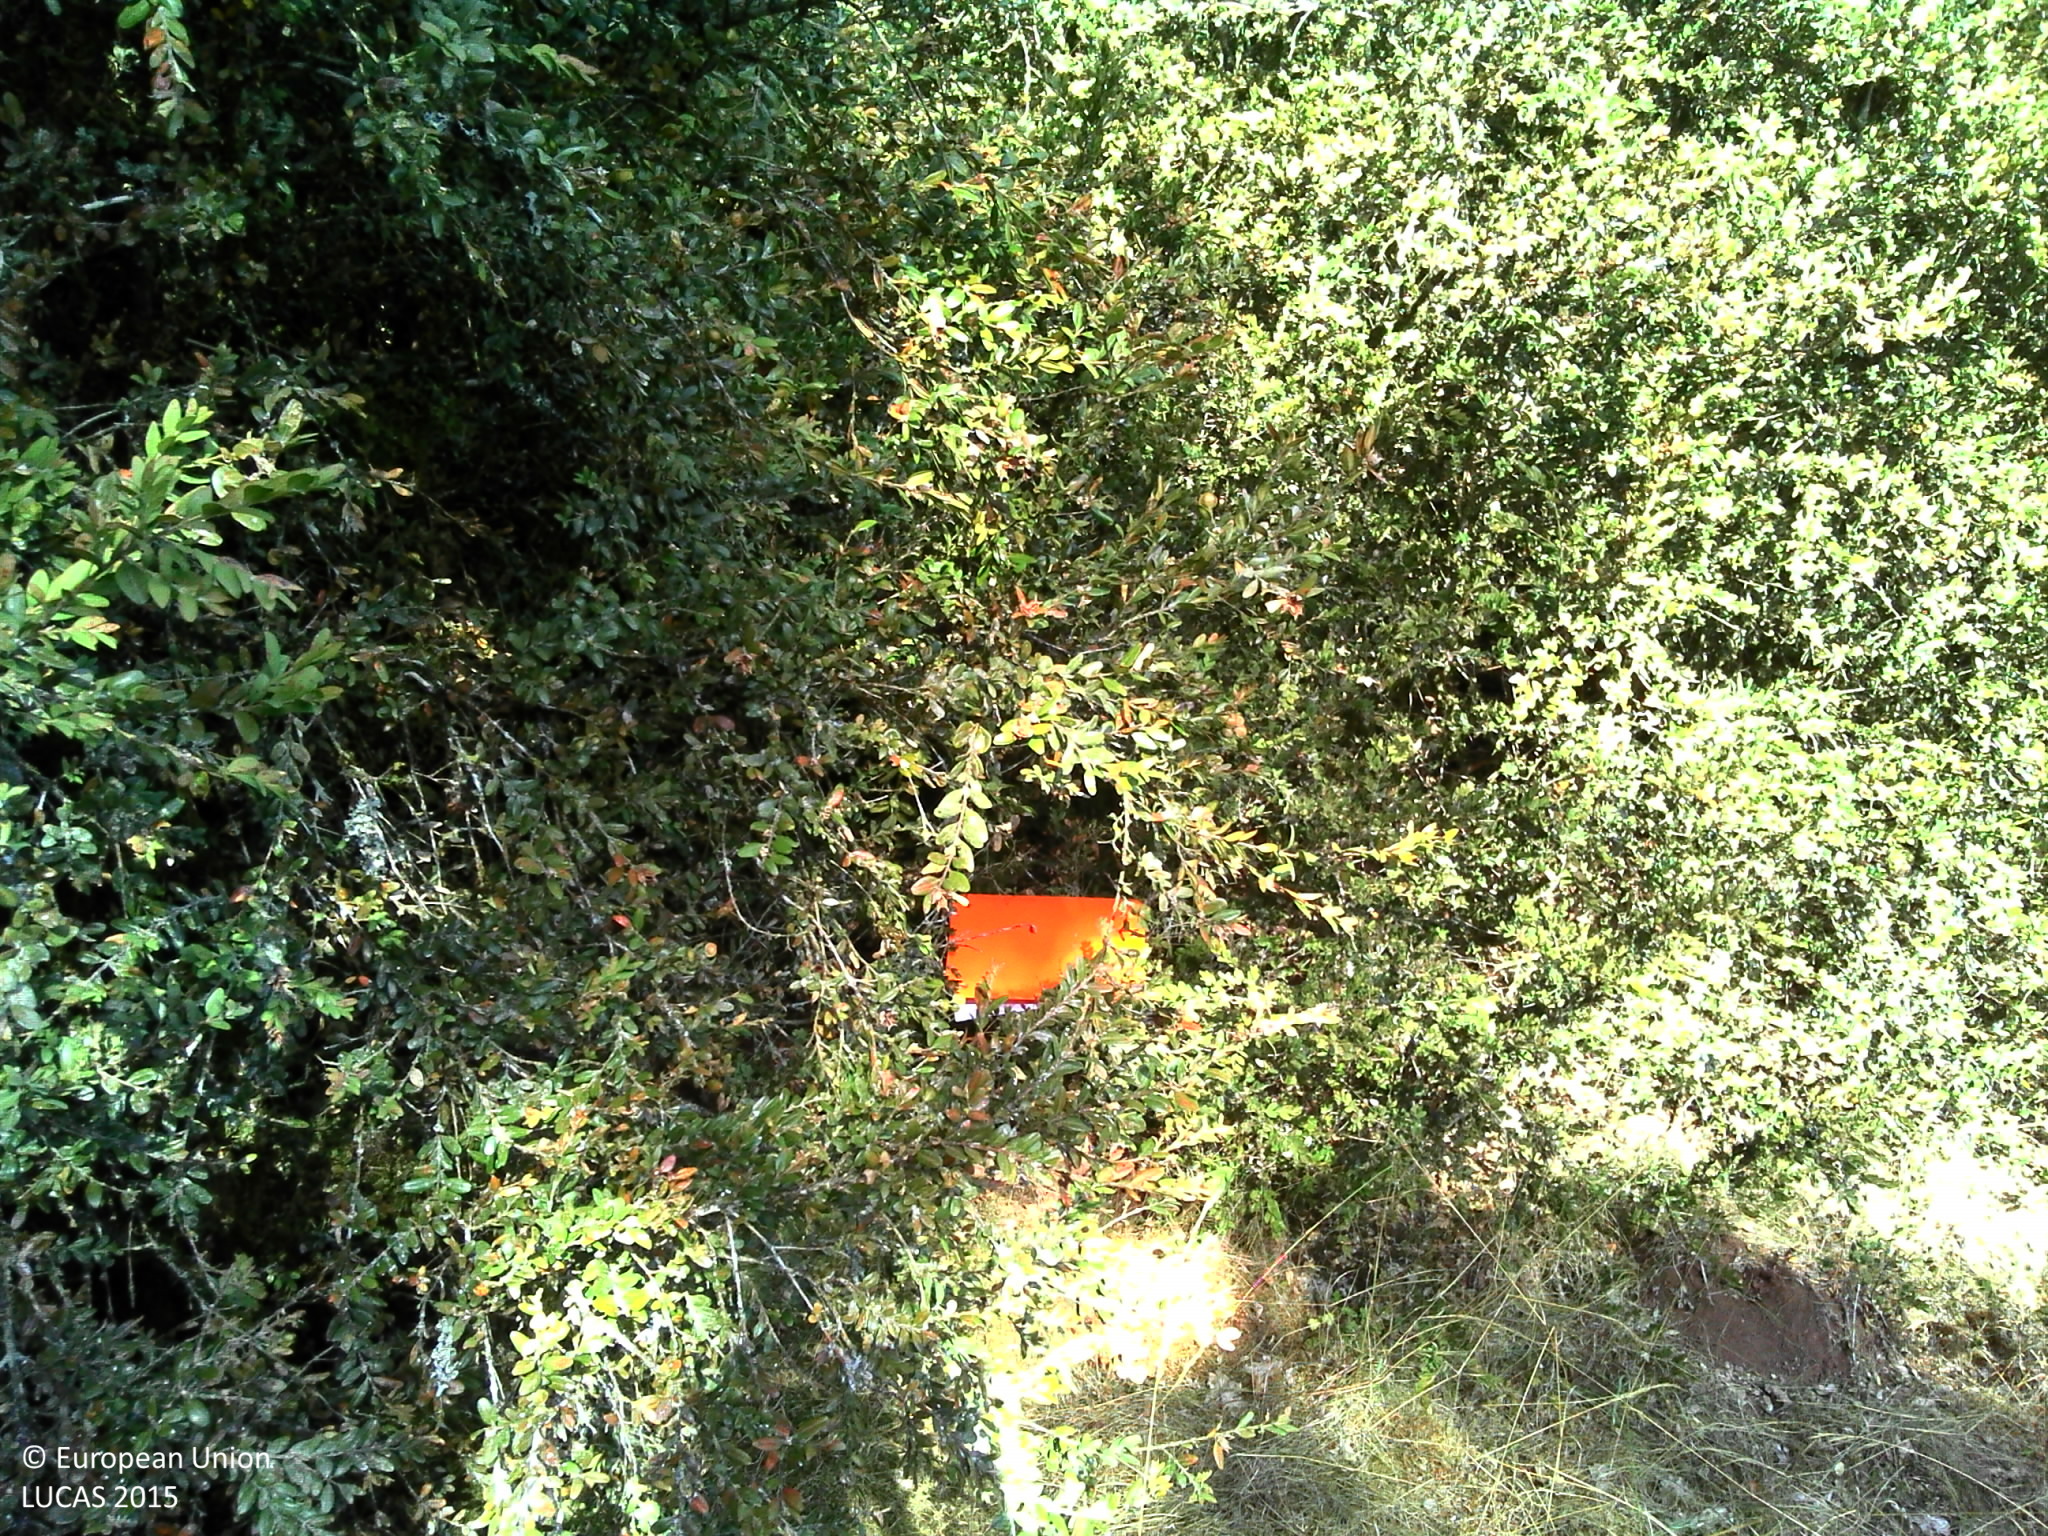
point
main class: Woodland
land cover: Broadleaved woodland
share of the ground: > 75 %
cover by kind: broadleaved forest trees 70 %, herbaceous plants 15 %, shrubs 10 %, lichens and mosses 5 %
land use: Forestry
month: August
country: FR
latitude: 43.8871
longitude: 3.1235
